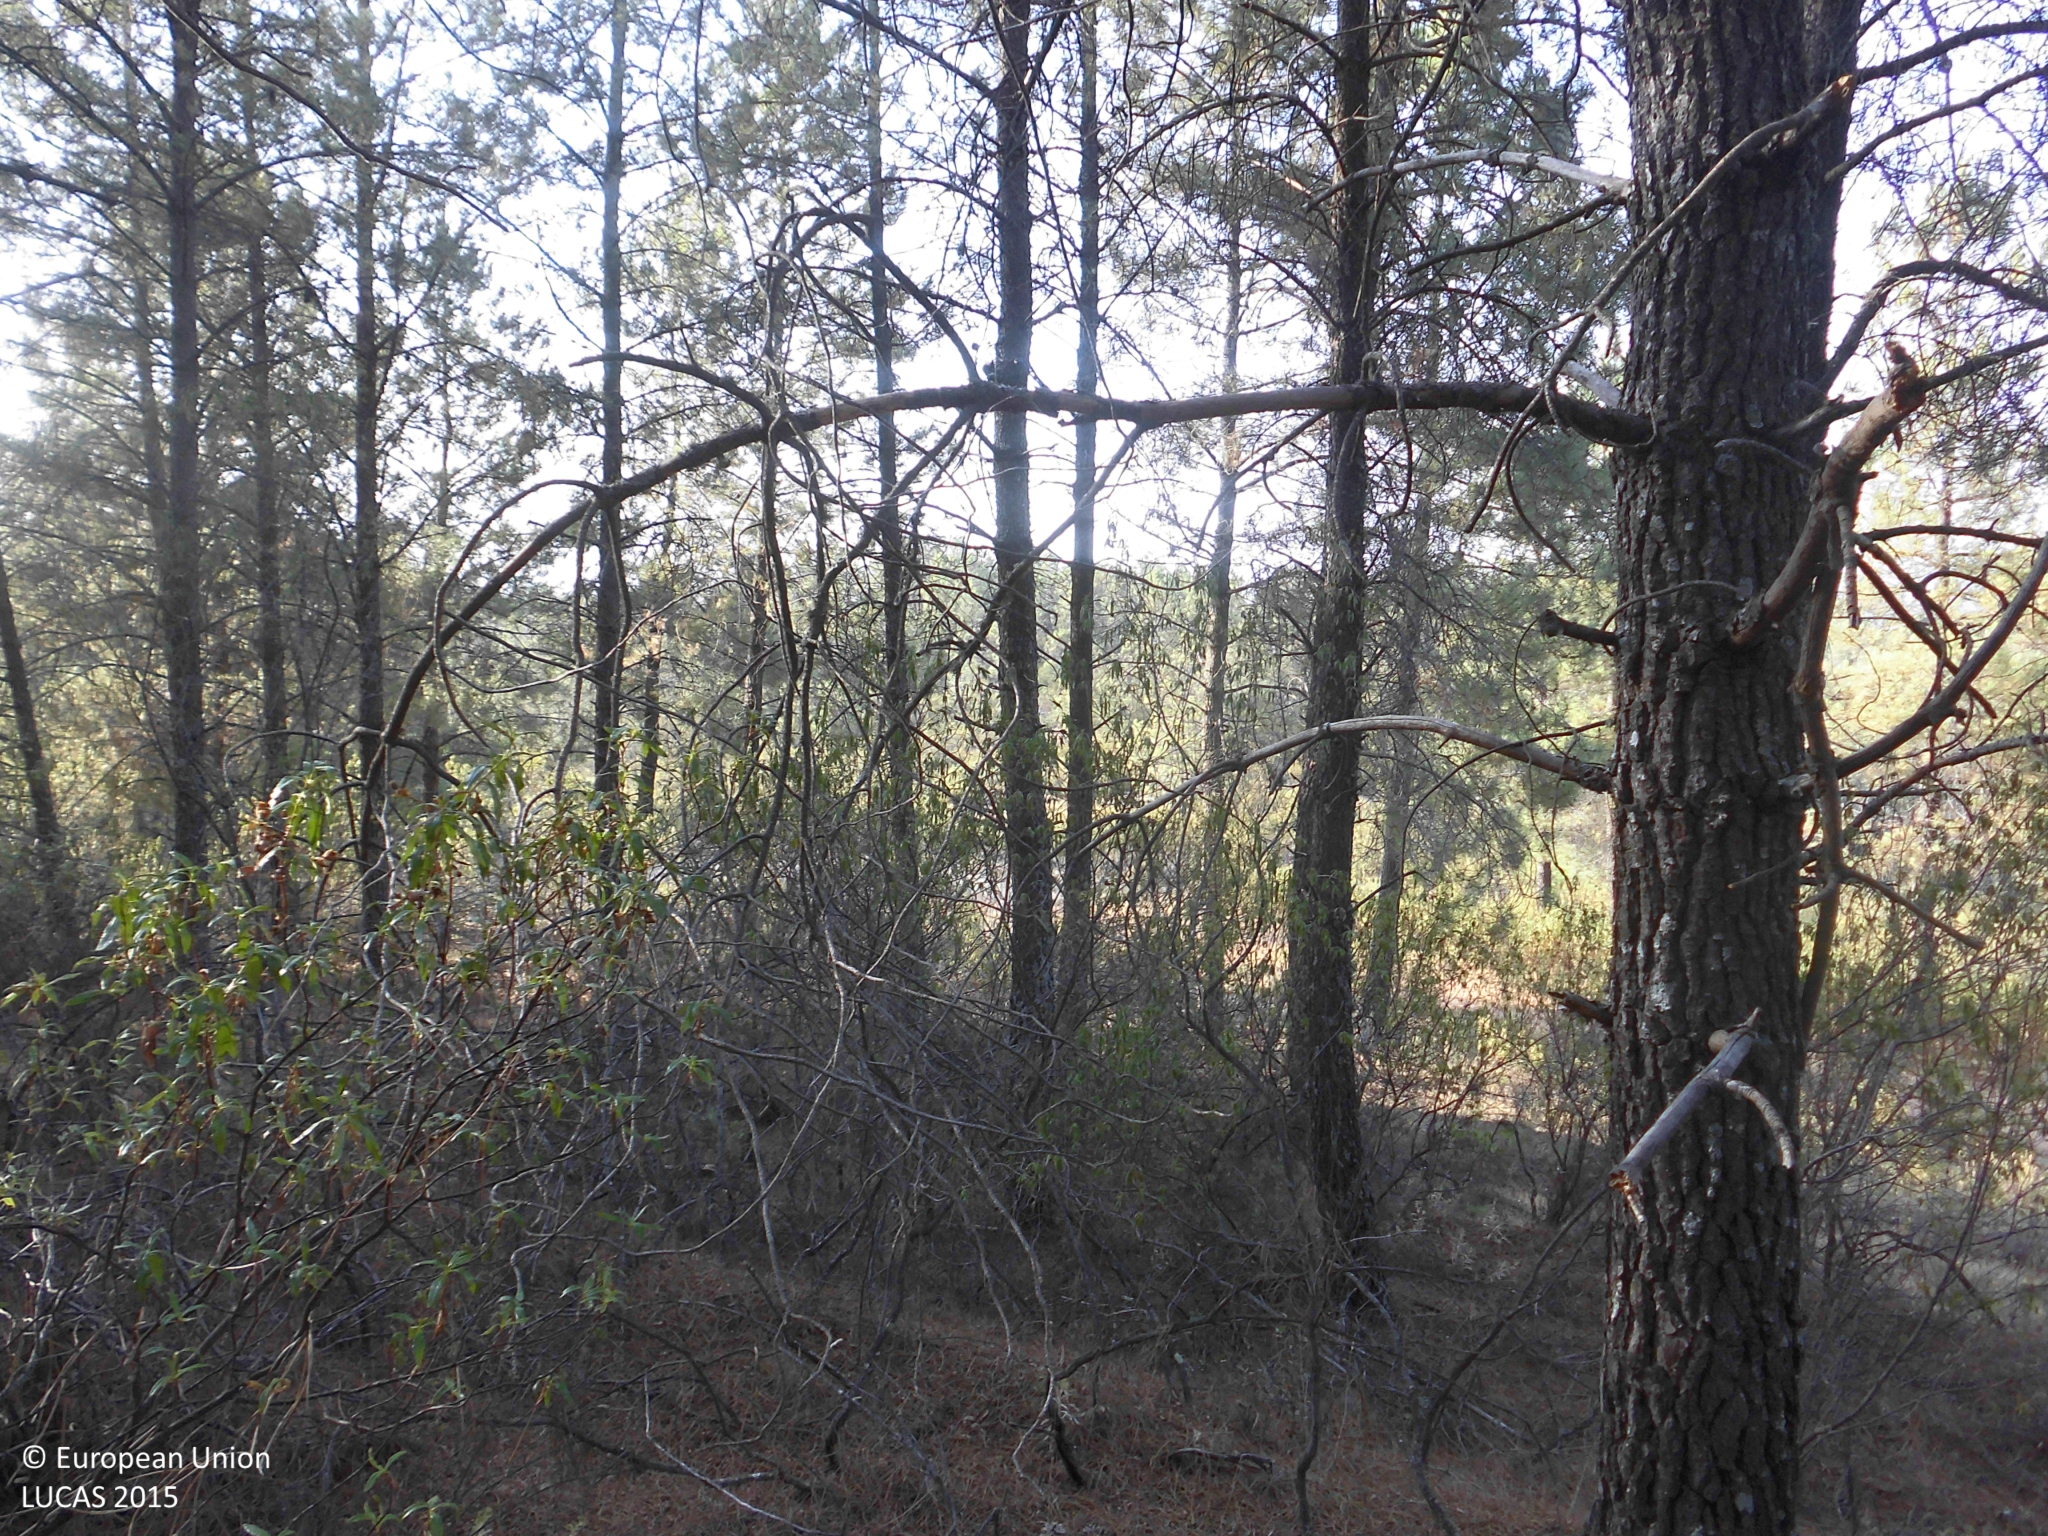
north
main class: Woodland
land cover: Pine dominated coniferous woodland
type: coniferous forest of the mediterranean region
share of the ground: > 75 %
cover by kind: coniferous forest trees 85 %, shrubs 10 %, herbaceous plants 5 %
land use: Forestry
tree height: > 5 m
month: July
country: ES
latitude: 39.7227
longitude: -5.6323
